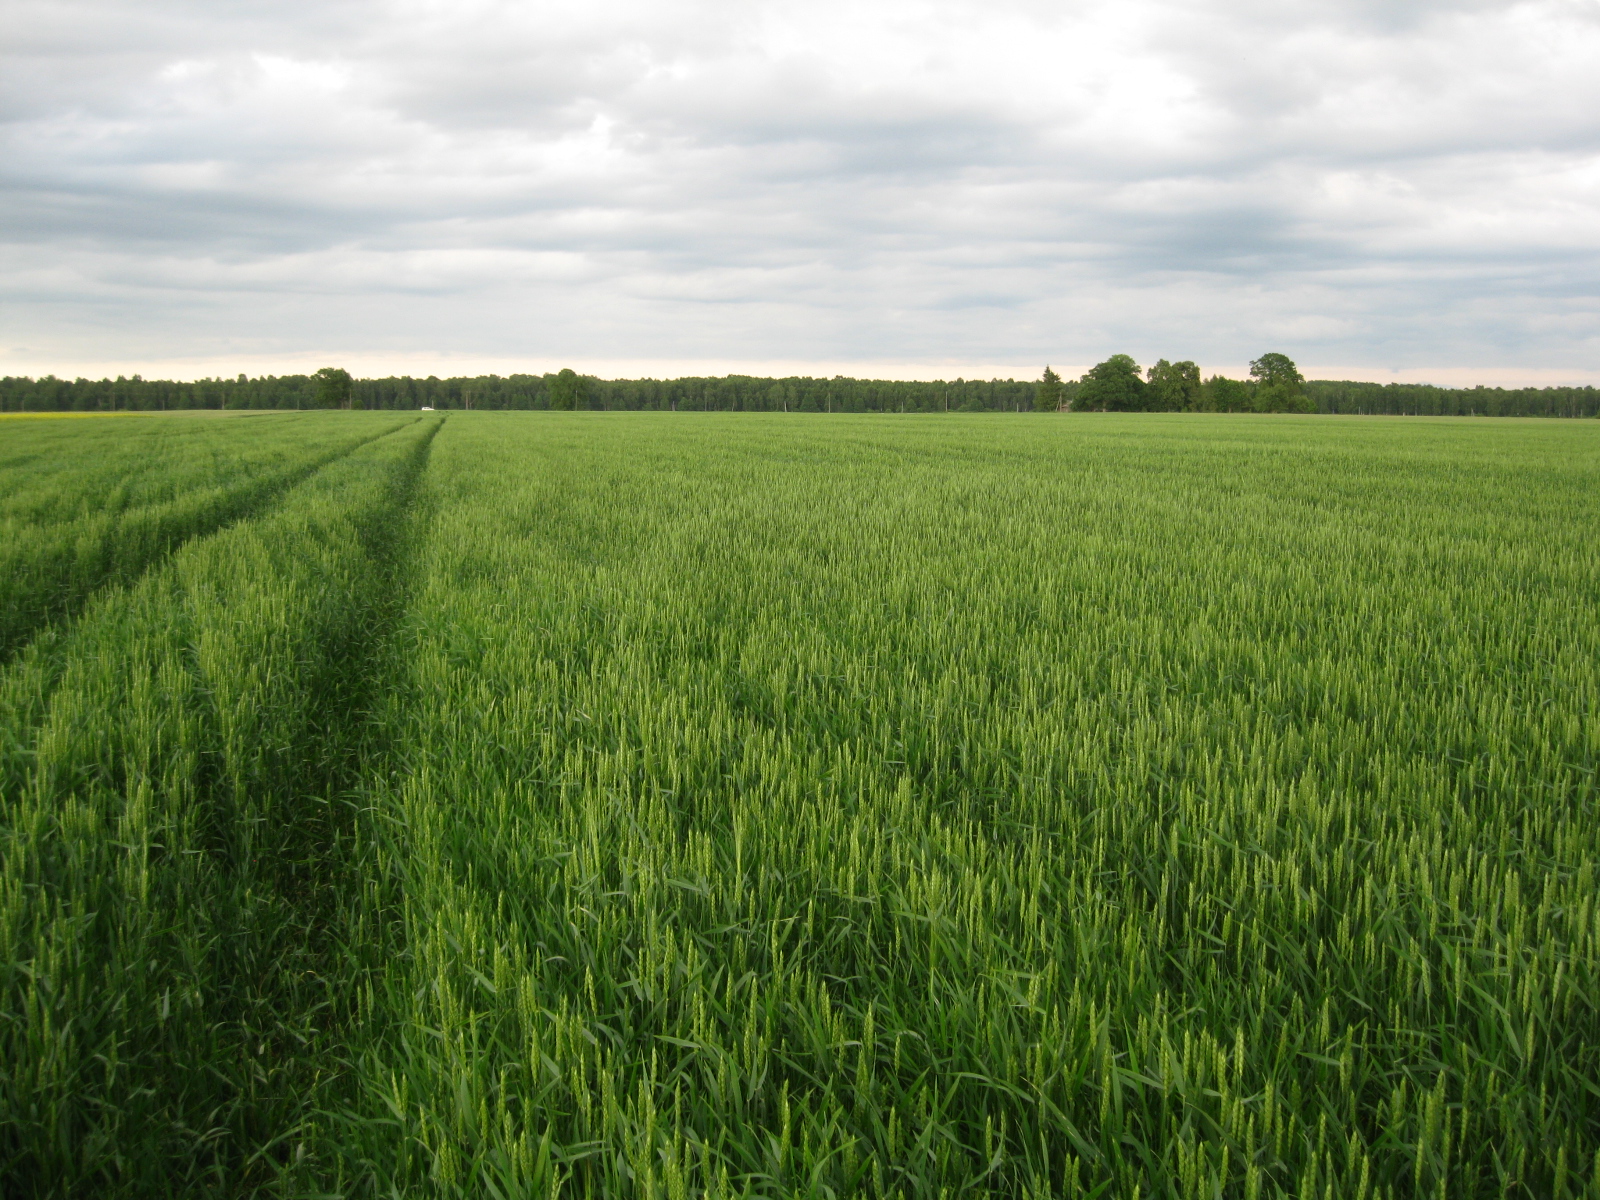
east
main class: Cropland
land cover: Common wheat
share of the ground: > 75 %
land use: Agriculture (excluding fallow land and kitchen gardens)
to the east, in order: Common wheat
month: June
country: LT
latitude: 55.4671
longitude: 24.1866
